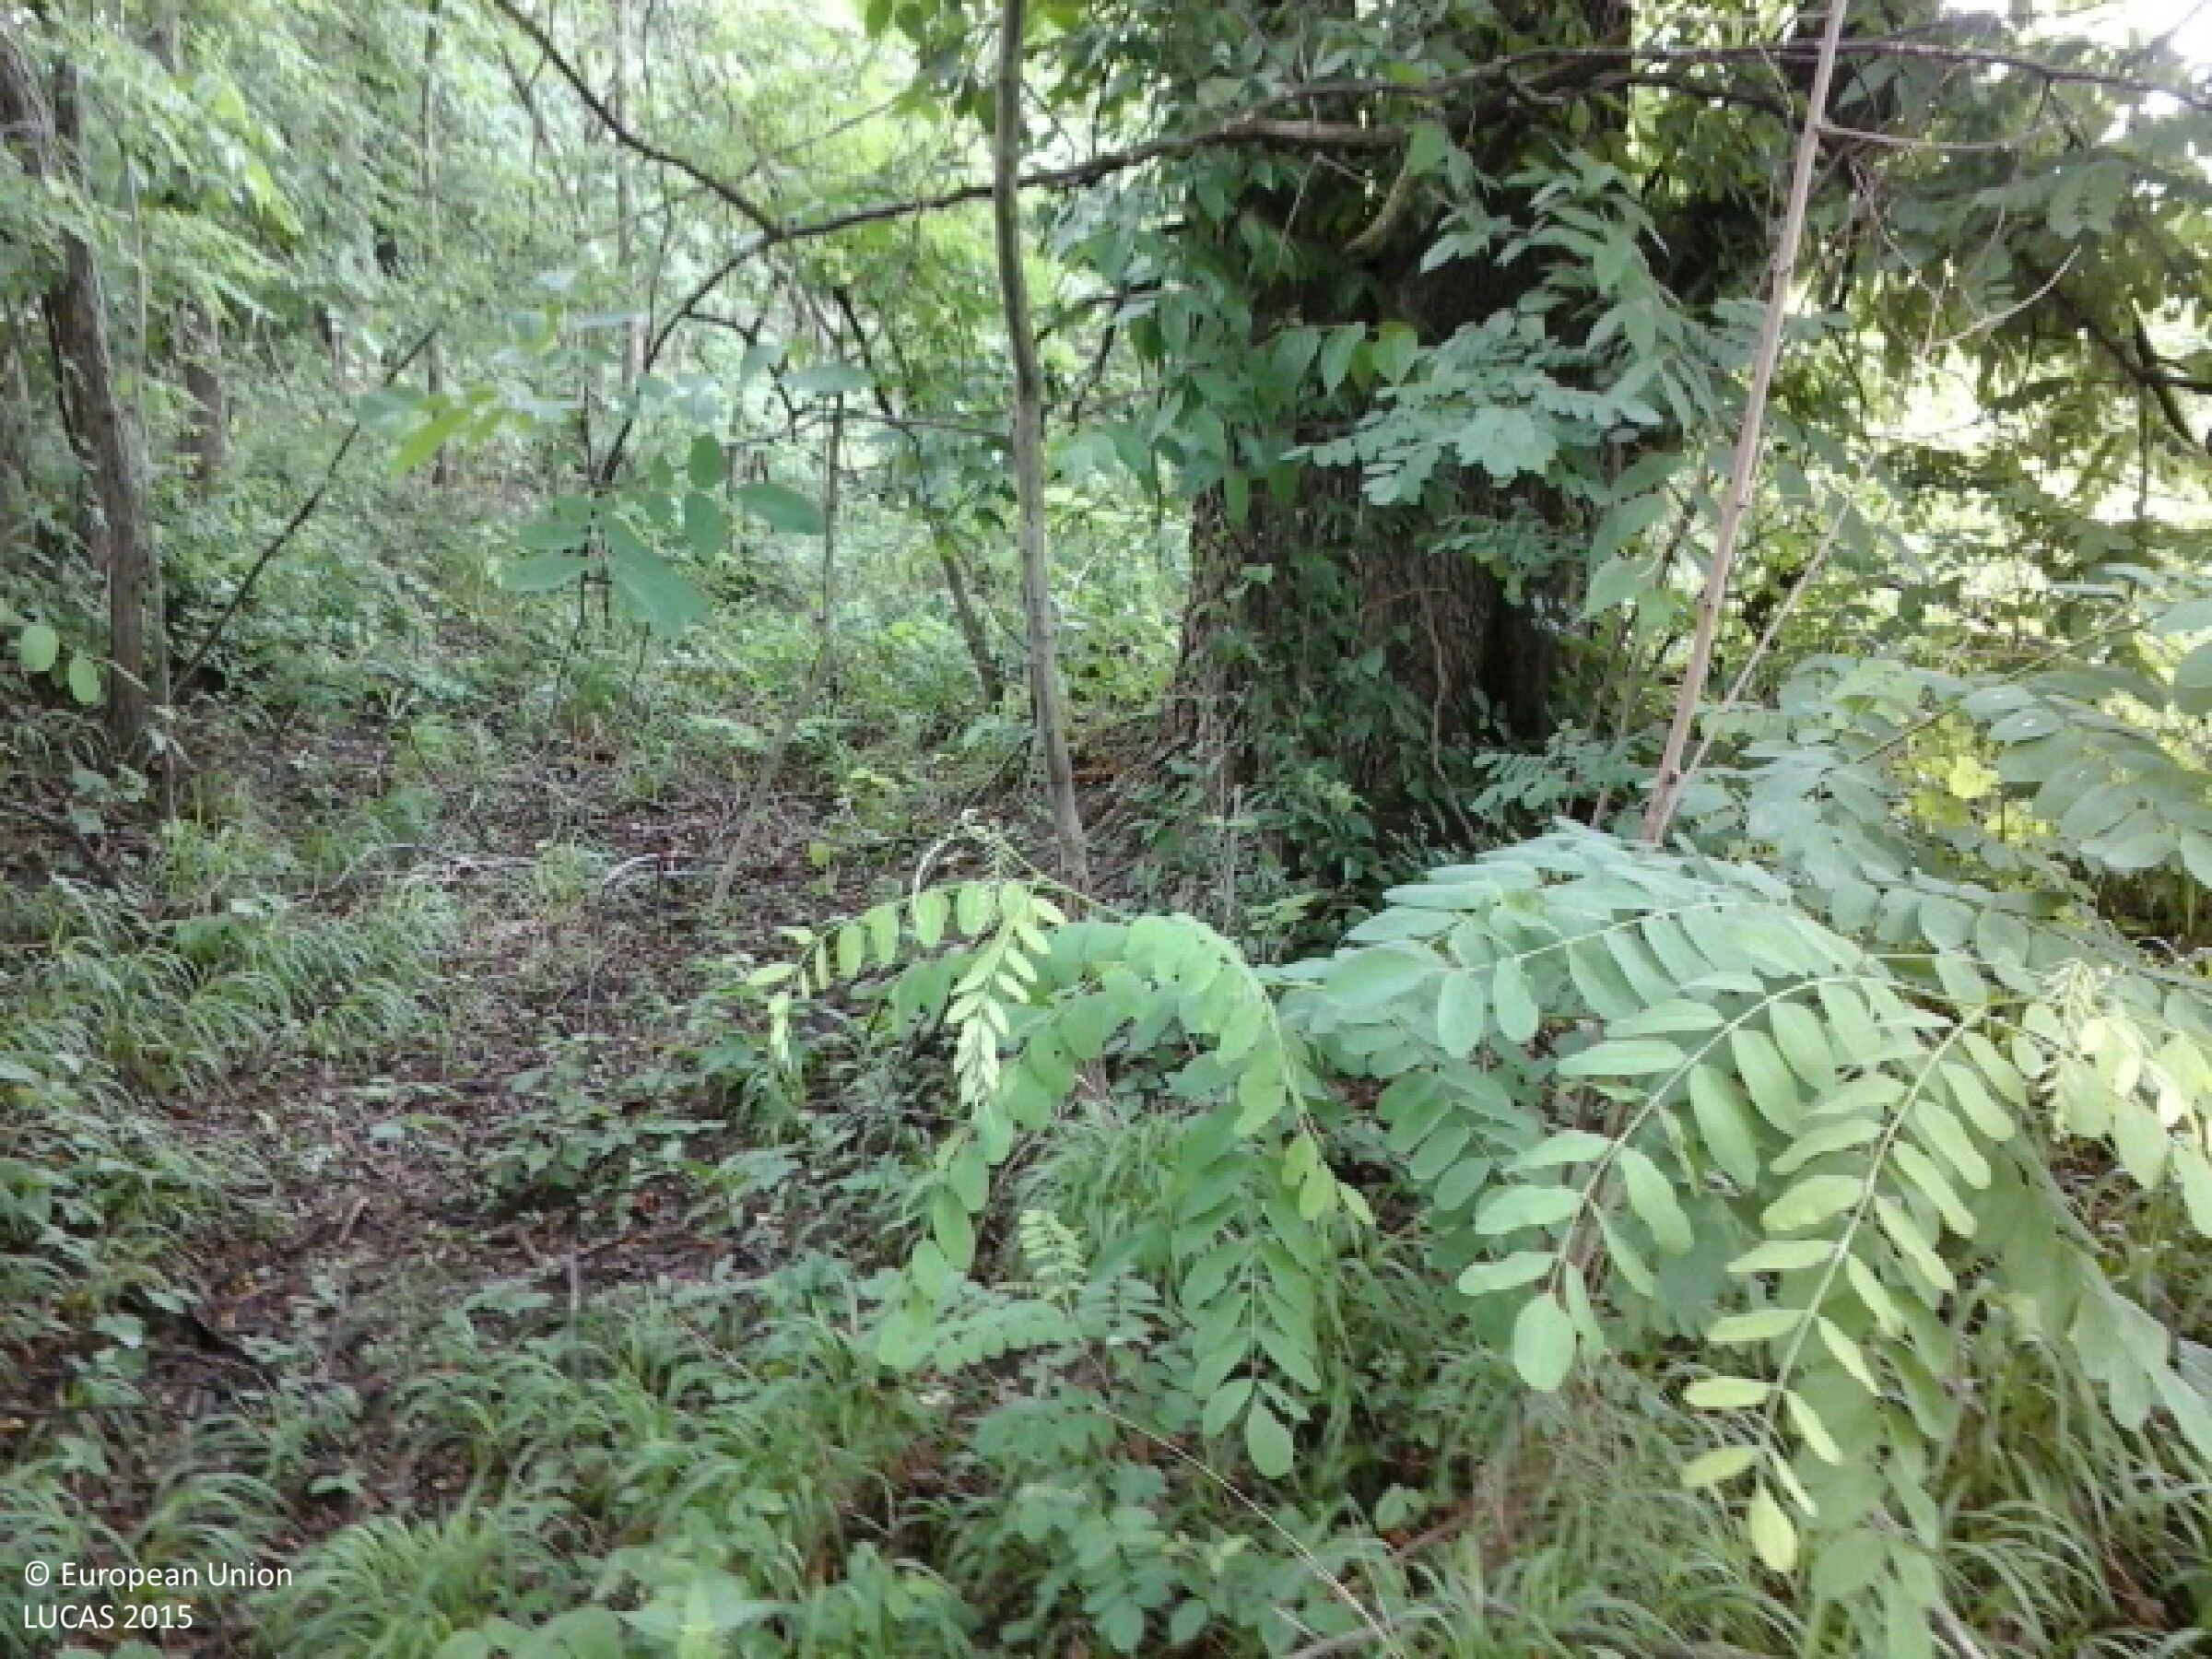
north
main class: Woodland
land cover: Broadleaved woodland
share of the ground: > 75 %
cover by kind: broadleaved forest trees 90 %, shrubs 5 %, herbaceous plants 5 %
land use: Forestry
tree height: > 5 m
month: June
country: HU
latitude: 47.9341
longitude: 21.7879
